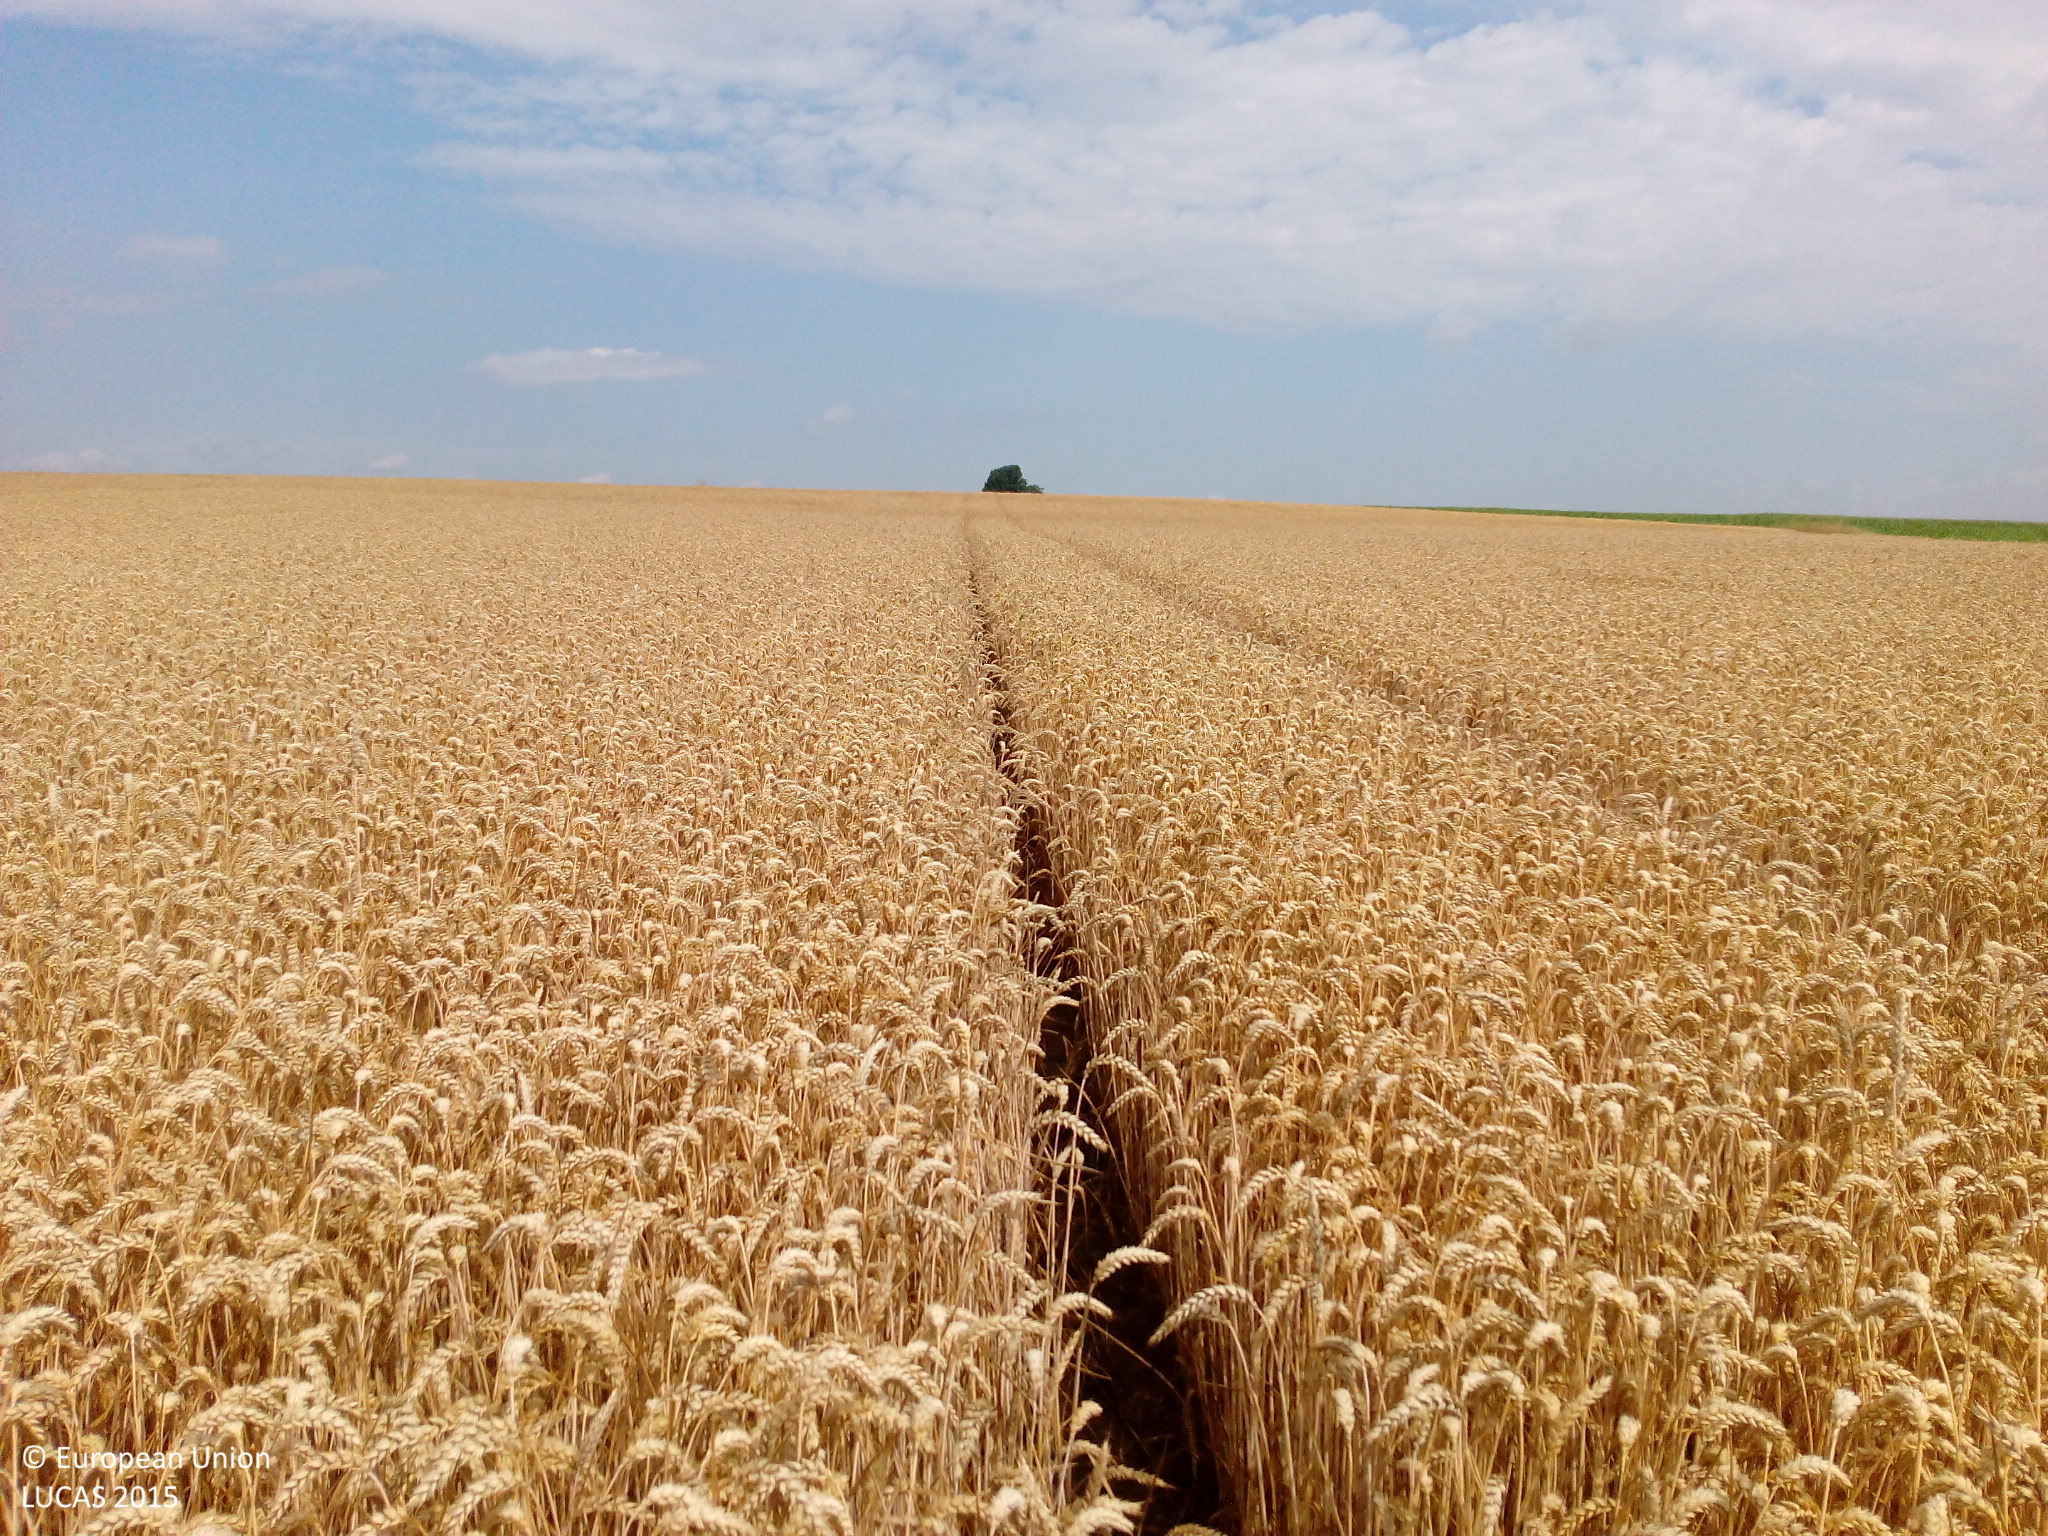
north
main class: Cropland
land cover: Common wheat
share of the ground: > 75 %
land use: Agriculture (excluding fallow land and kitchen gardens)
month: July
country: DE
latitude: 49.5148
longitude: 10.9527
